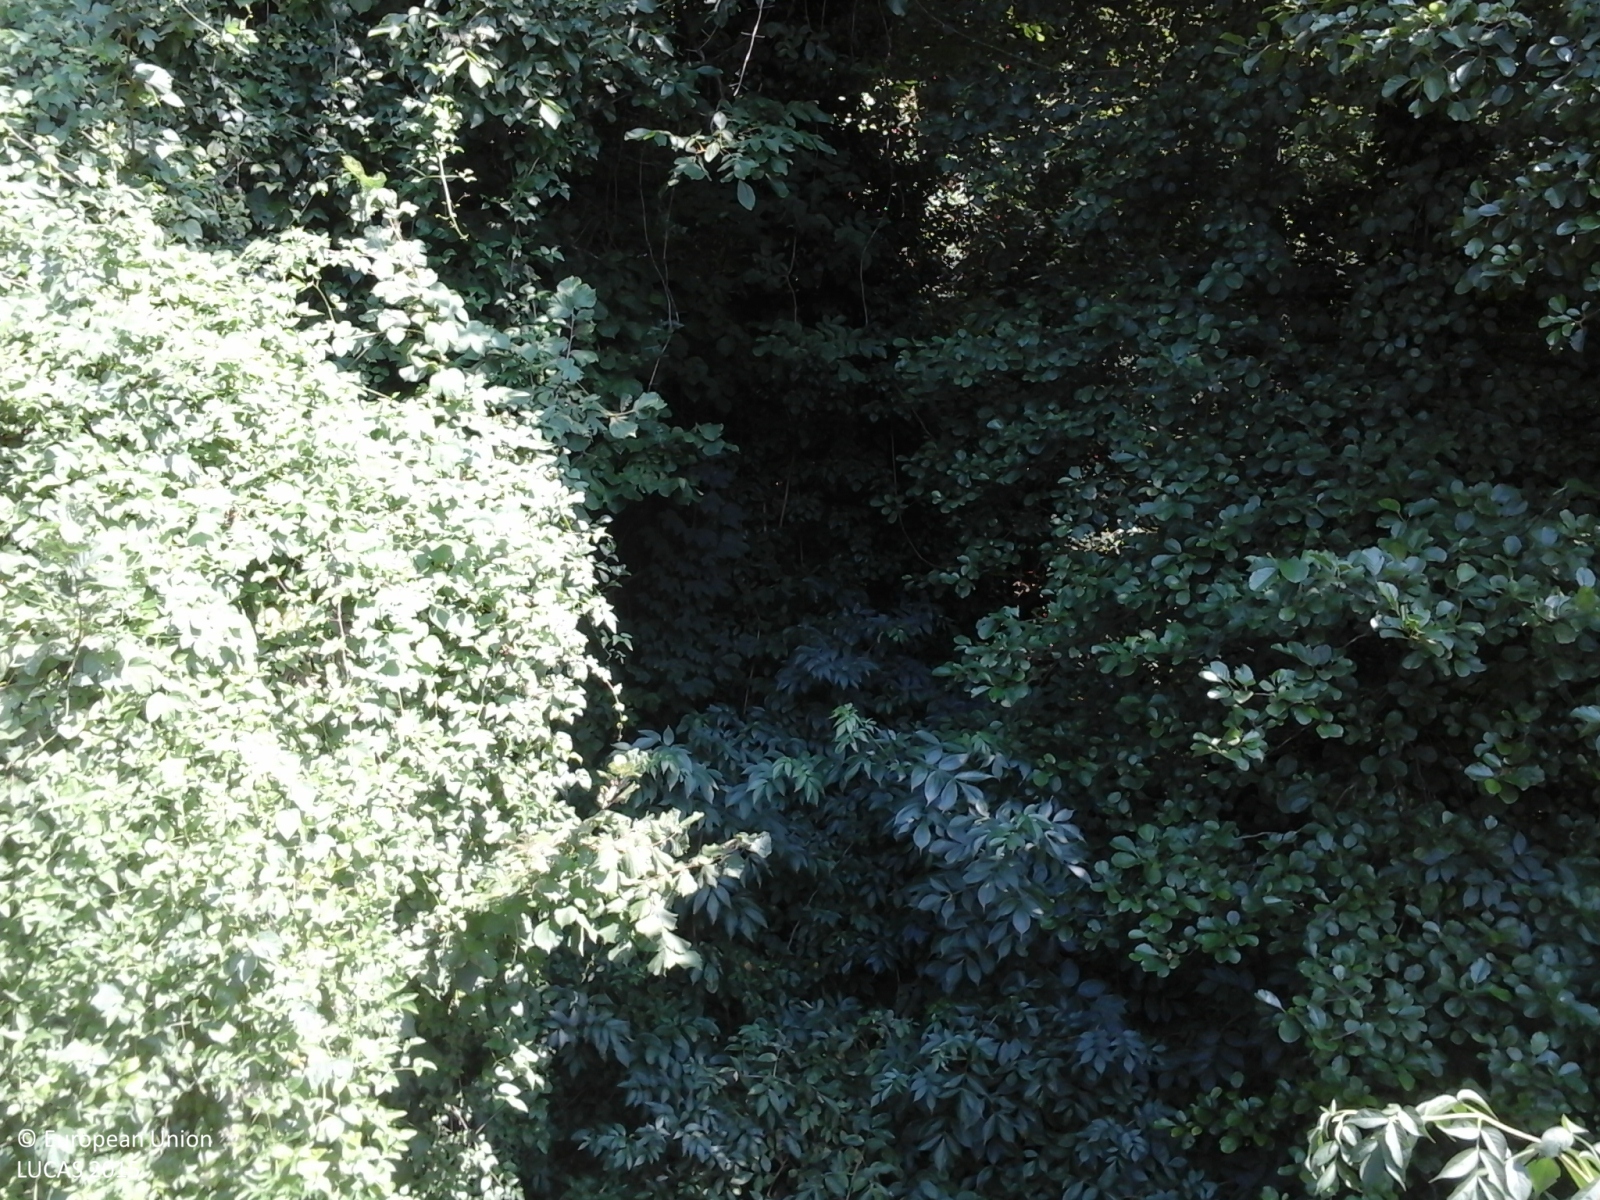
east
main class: Woodland
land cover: Broadleaved woodland
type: thermophilous deciduous forest
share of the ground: > 75 %
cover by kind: broadleaved forest trees 100 %
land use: Forestry
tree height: > 5 m
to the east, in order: Broadleaved woodland; Shrubland without tree cover; Artificial constructions in urban areas; Broadleaved woodland; Electric lines; Broadleaved woodland; Olive groves; Electric lines; Olive groves; Grass margins; Paved roads, cycling and walking lanes; Grass margins; Olive groves
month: August
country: IT
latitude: 43.9693
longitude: 10.7087
